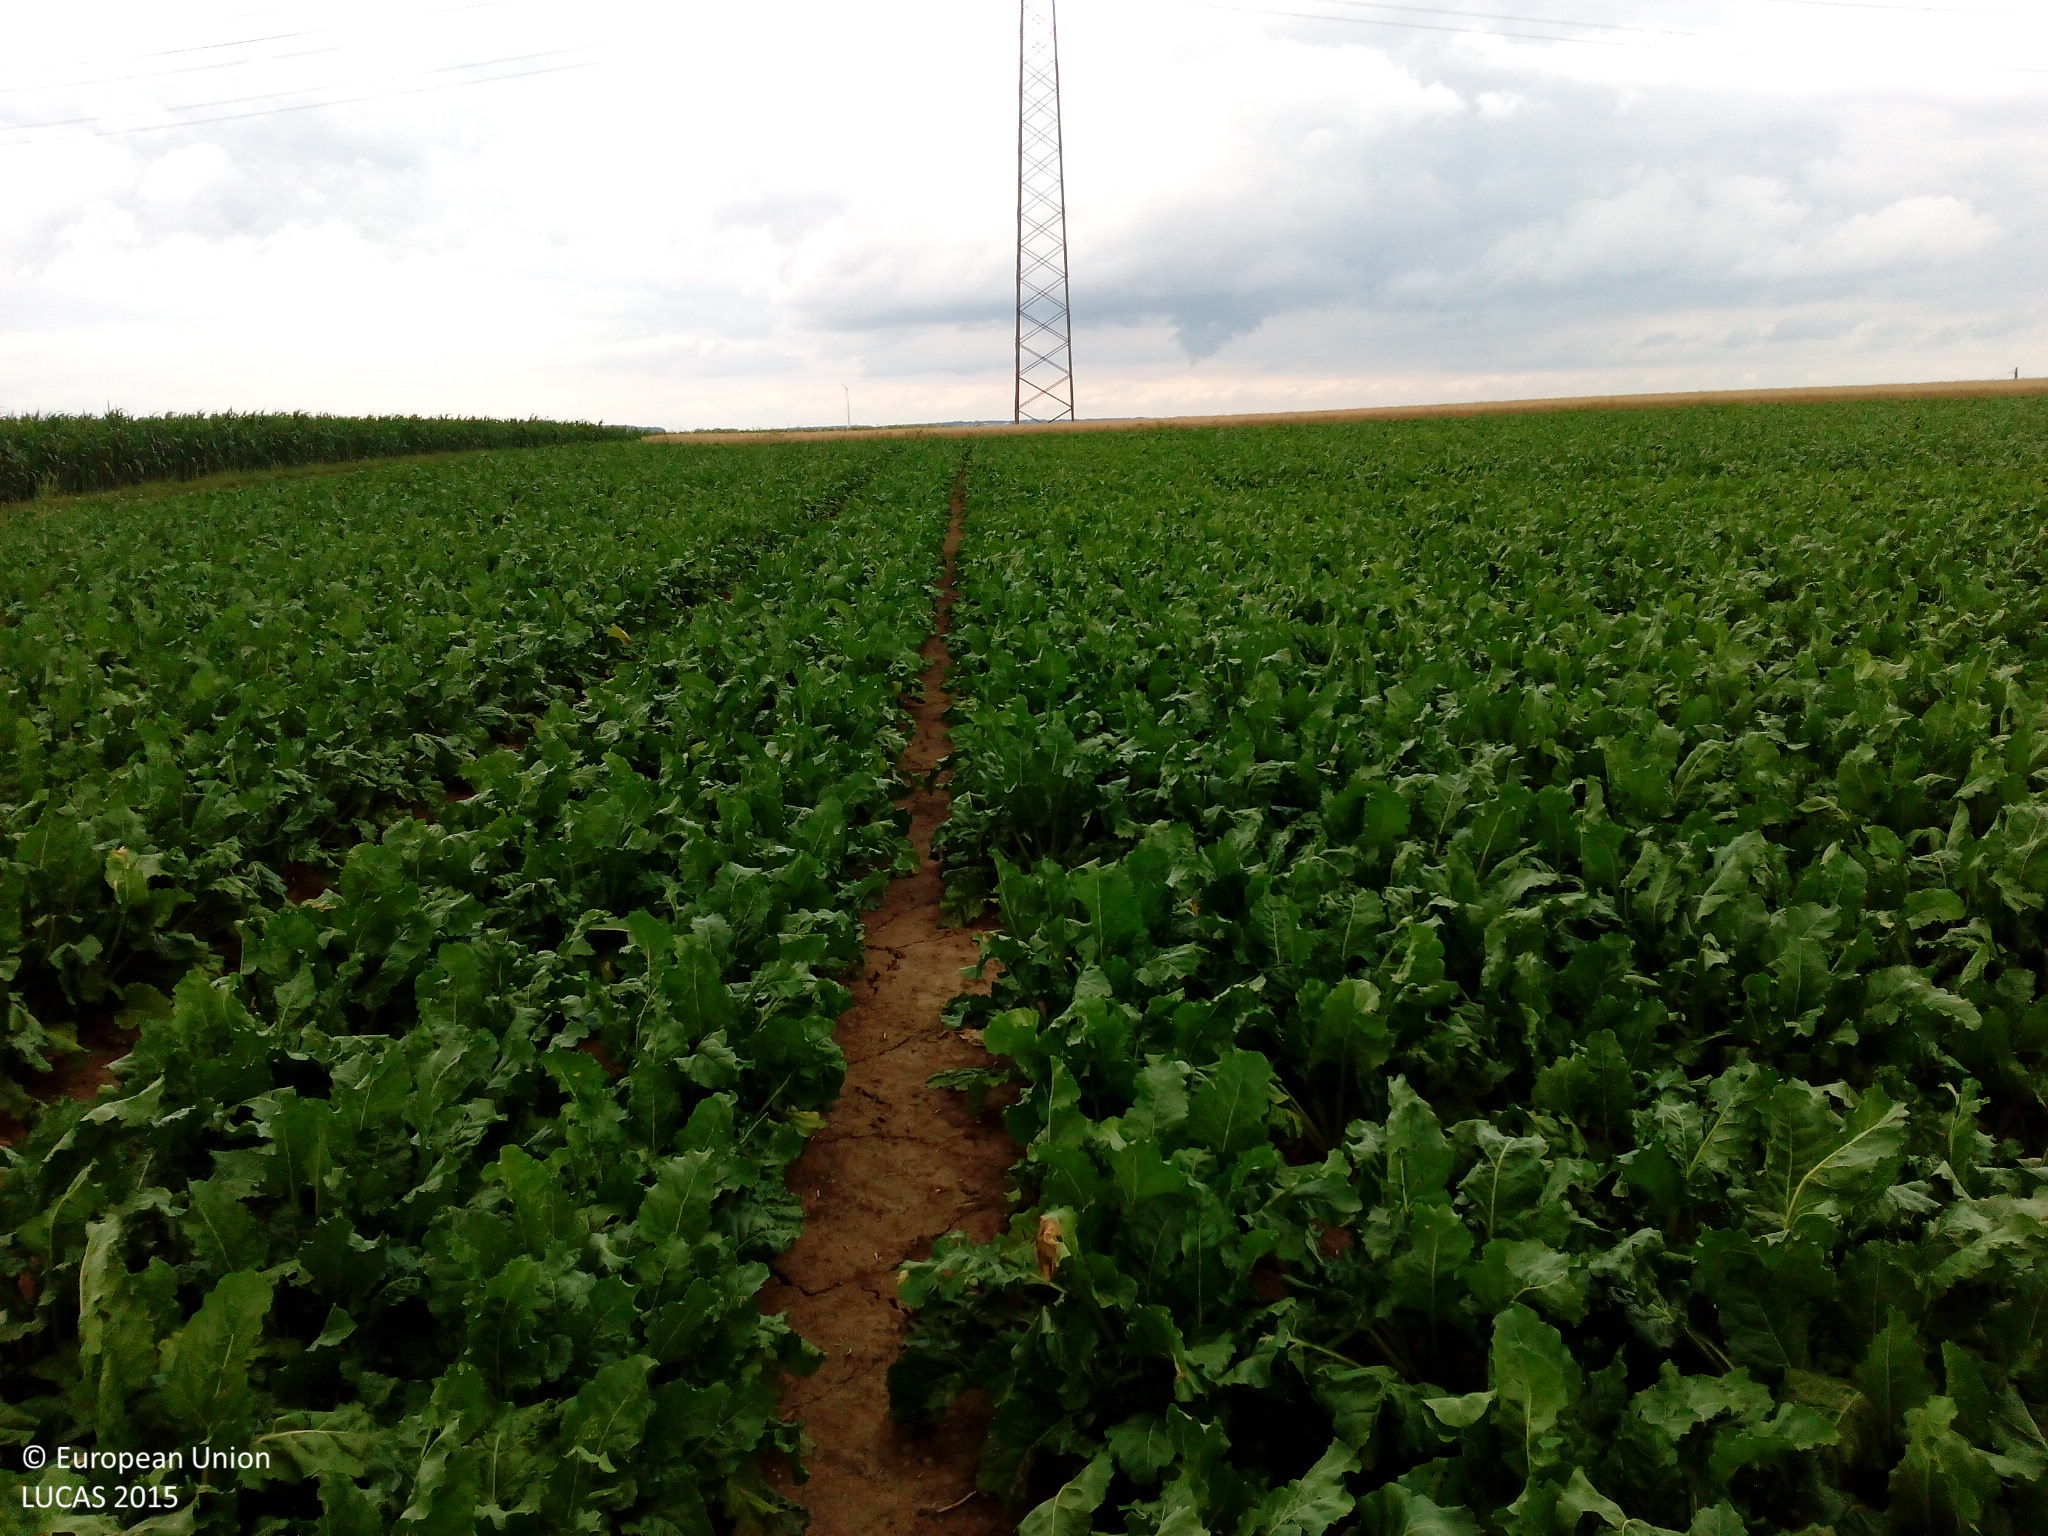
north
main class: Cropland
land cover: Sugar beet
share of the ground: > 75 %
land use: Agriculture (excluding fallow land and kitchen gardens)
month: July
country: DE
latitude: 48.9223
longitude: 9.1952
